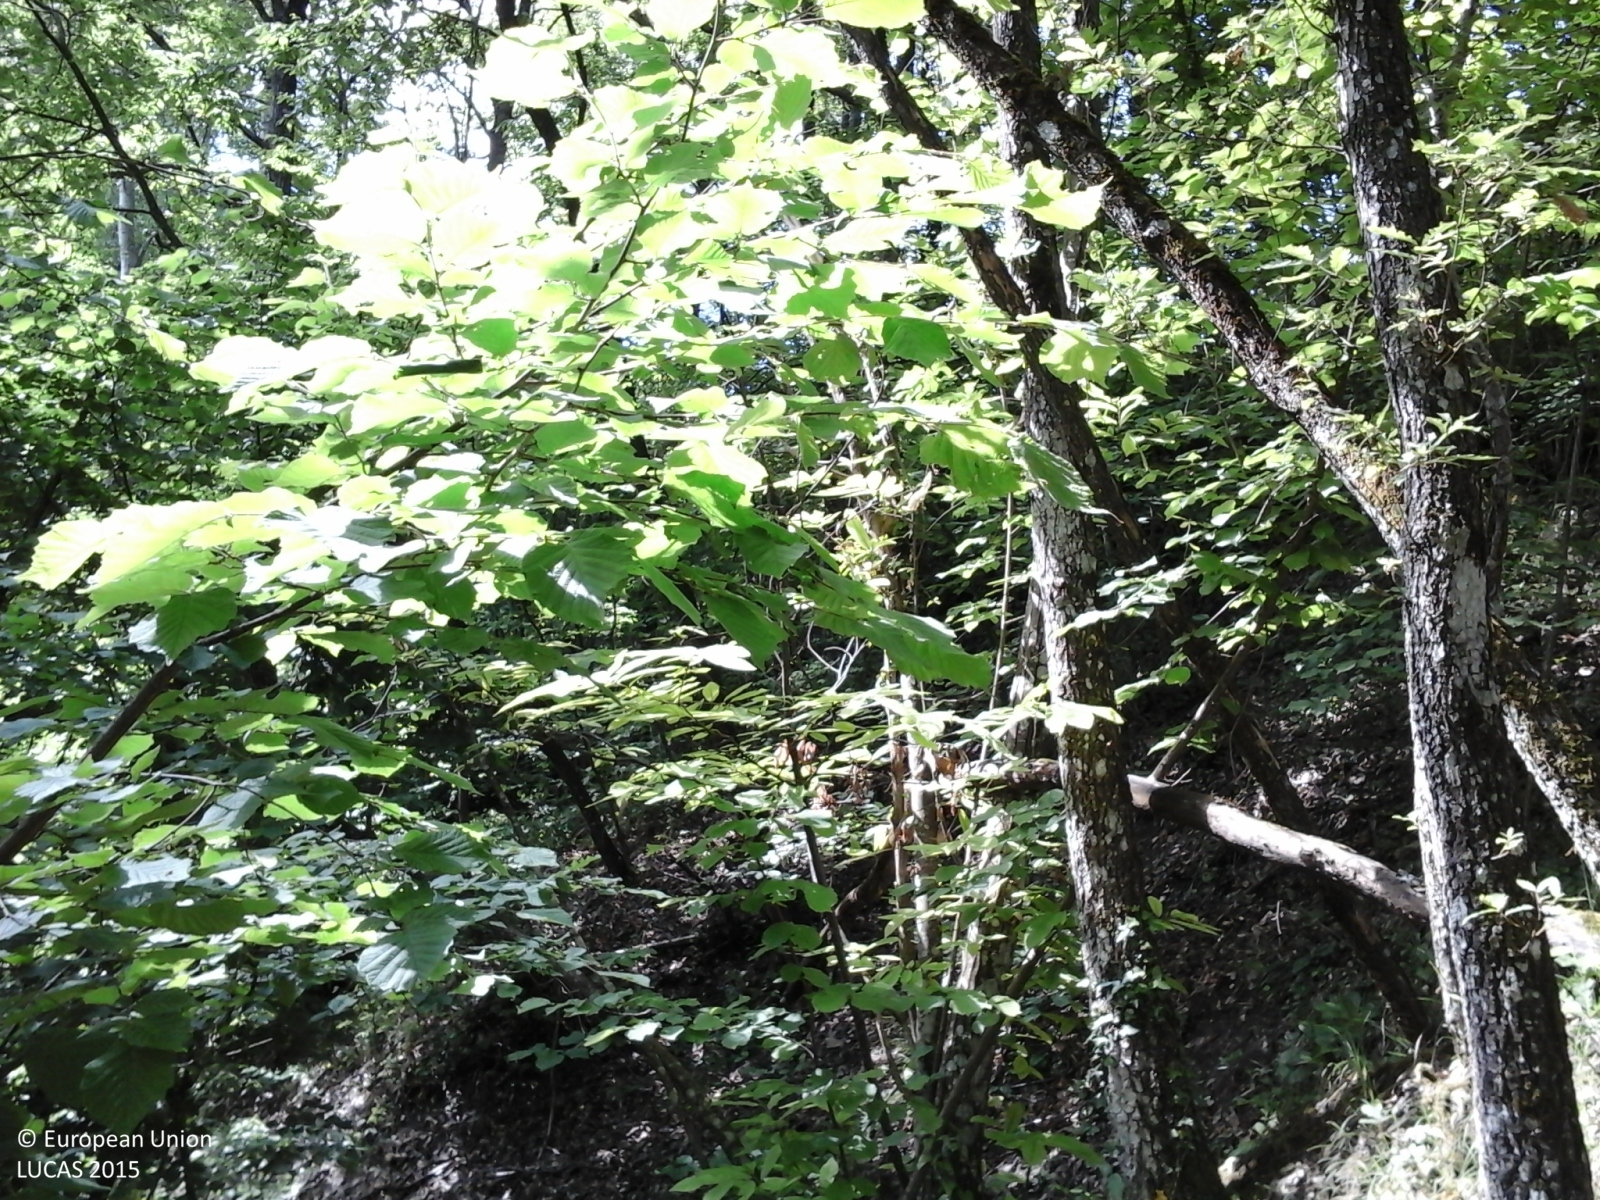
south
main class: Woodland
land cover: Broadleaved woodland
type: thermophilous deciduous forest
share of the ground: > 75 %
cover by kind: broadleaved forest trees 95 %, shrubs 5 %
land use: Forestry
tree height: > 5 m
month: May
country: IT
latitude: 44.5128
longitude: 10.1130
